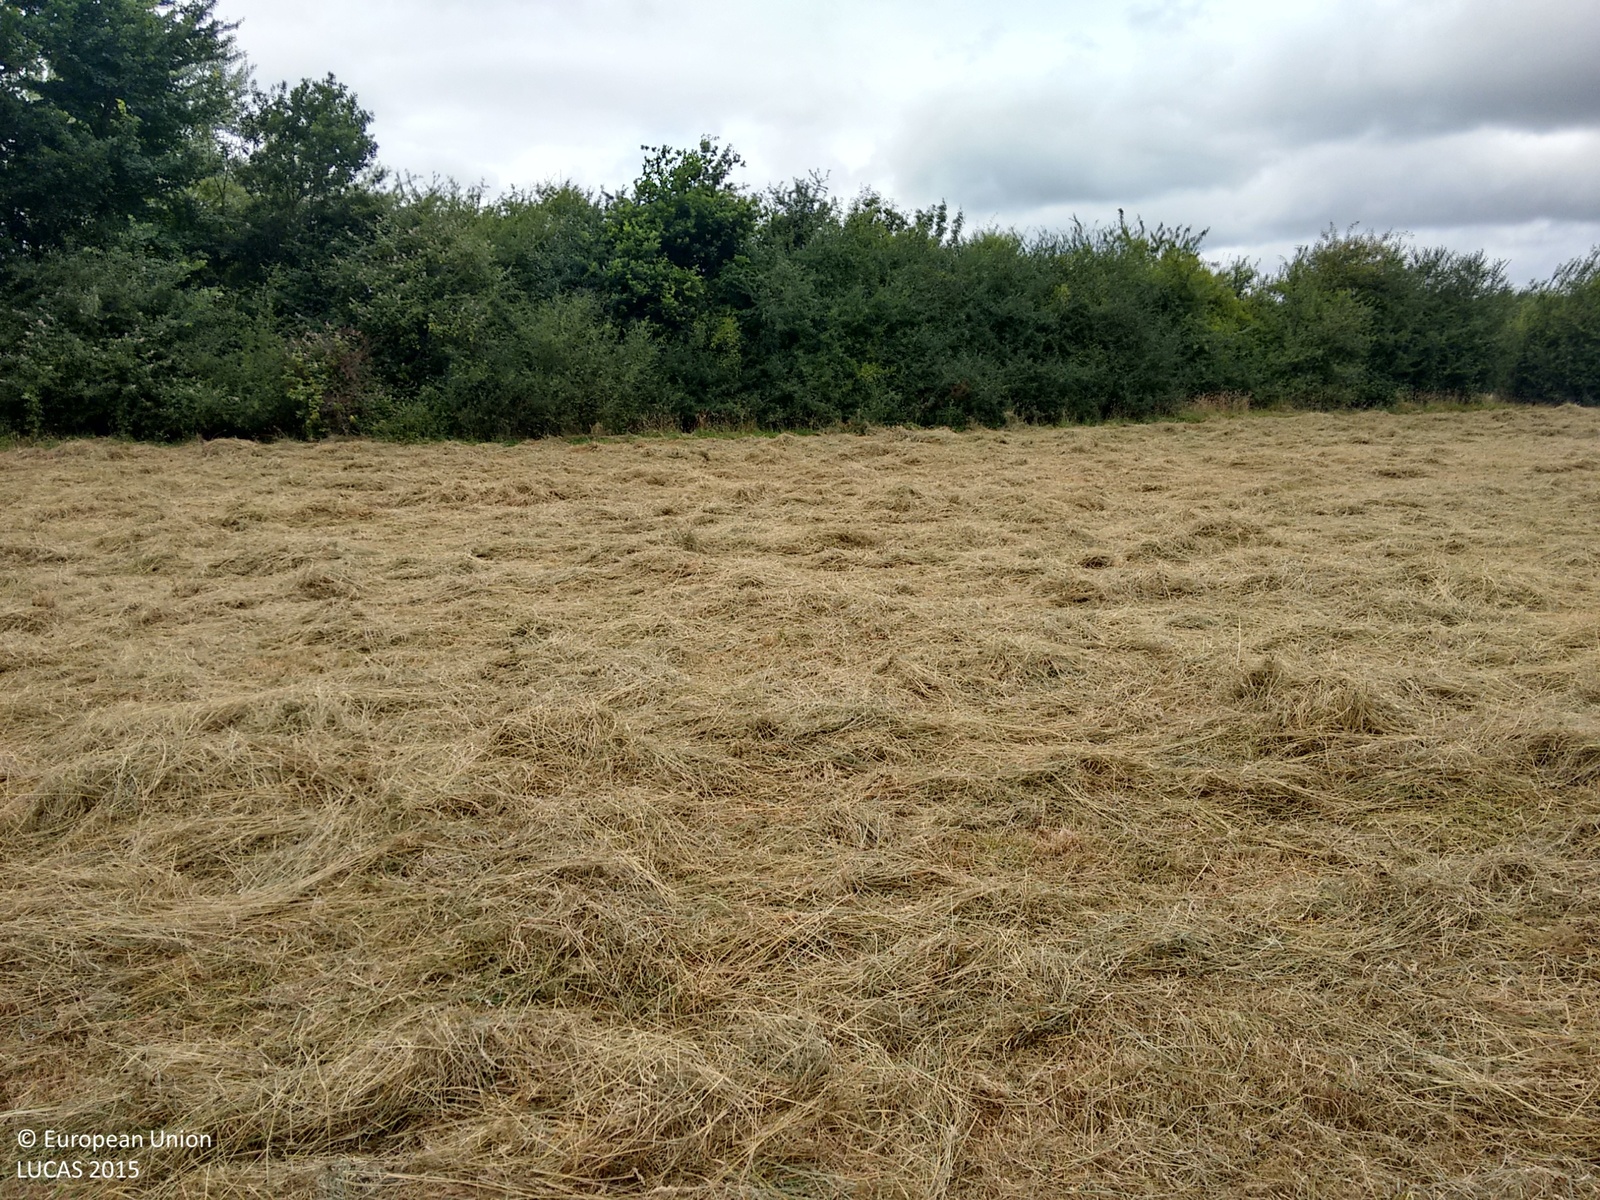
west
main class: Grassland
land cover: Grassland without tree/shrub cover
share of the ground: > 75 %
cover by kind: herbaceous plants 100 %
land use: Agriculture (excluding fallow land and kitchen gardens)
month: July
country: GB
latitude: 51.0788
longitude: -0.4723
